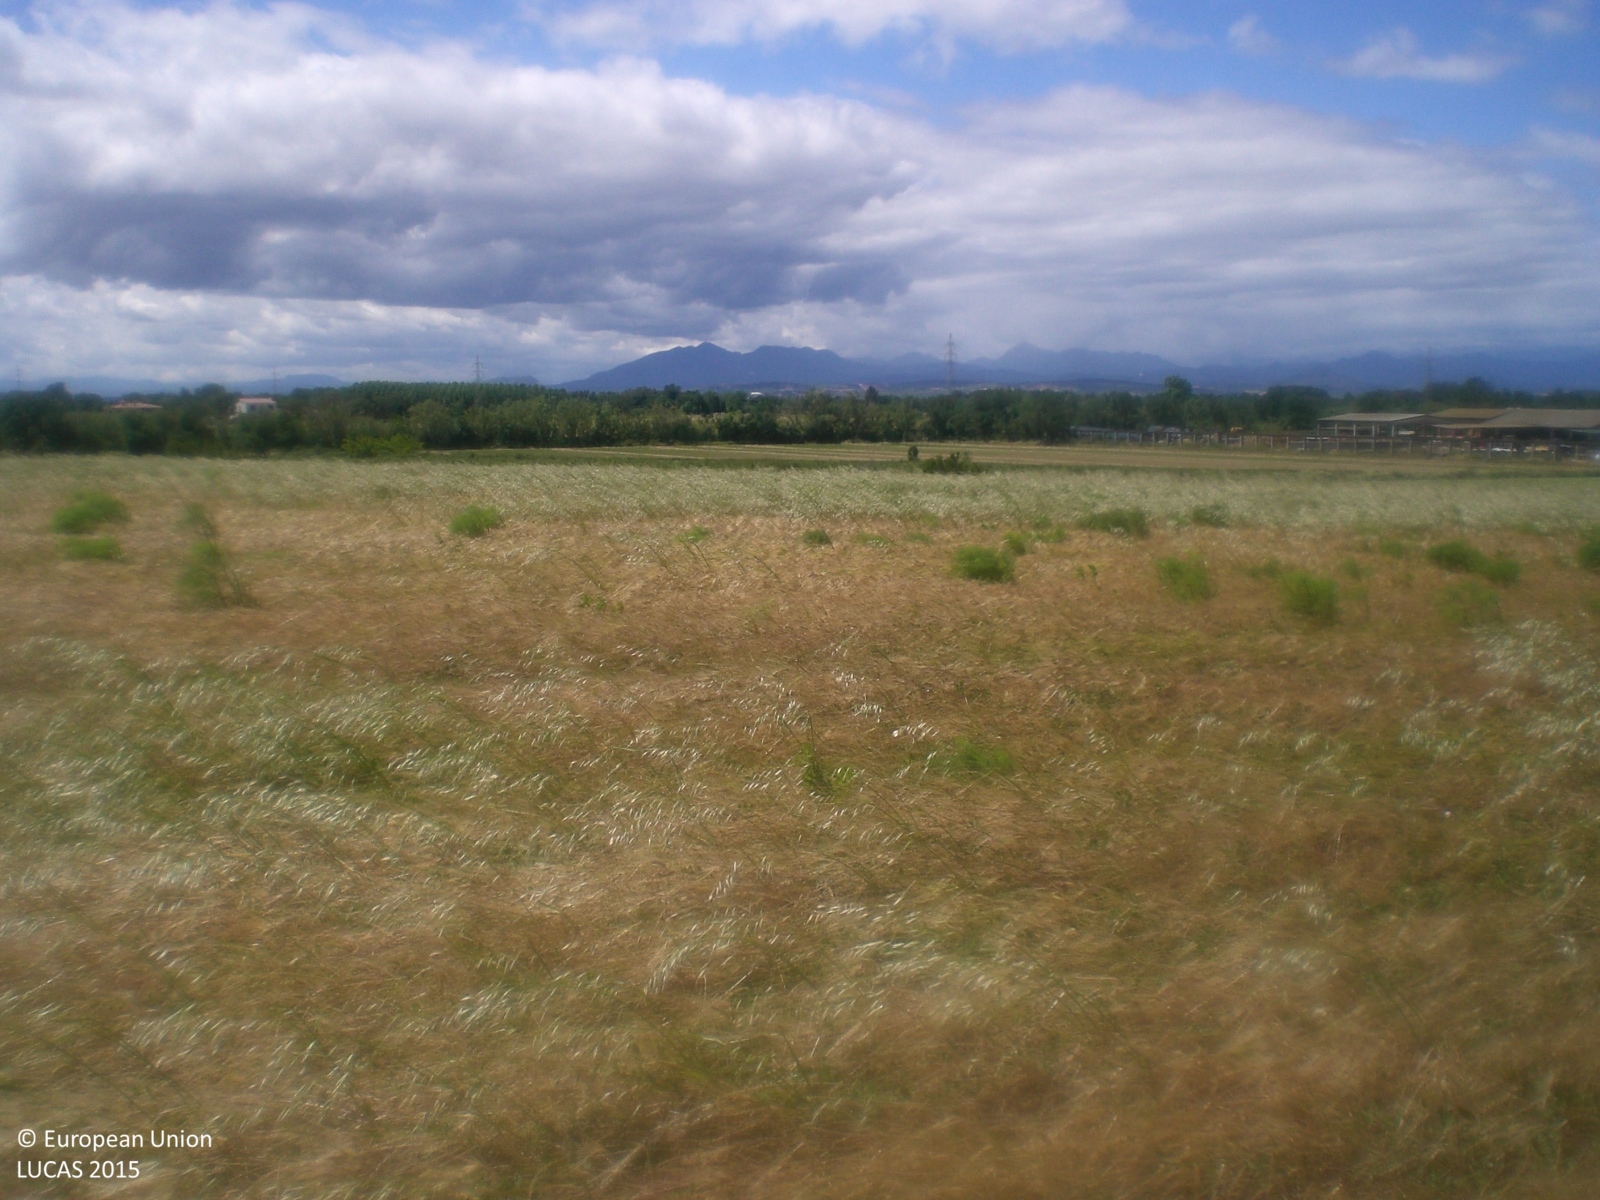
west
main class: Cropland
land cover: Barley
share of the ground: > 75 %
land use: Agriculture (excluding fallow land and kitchen gardens)
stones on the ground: > 50 %
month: May
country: ES
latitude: 42.2713
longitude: 3.0670
